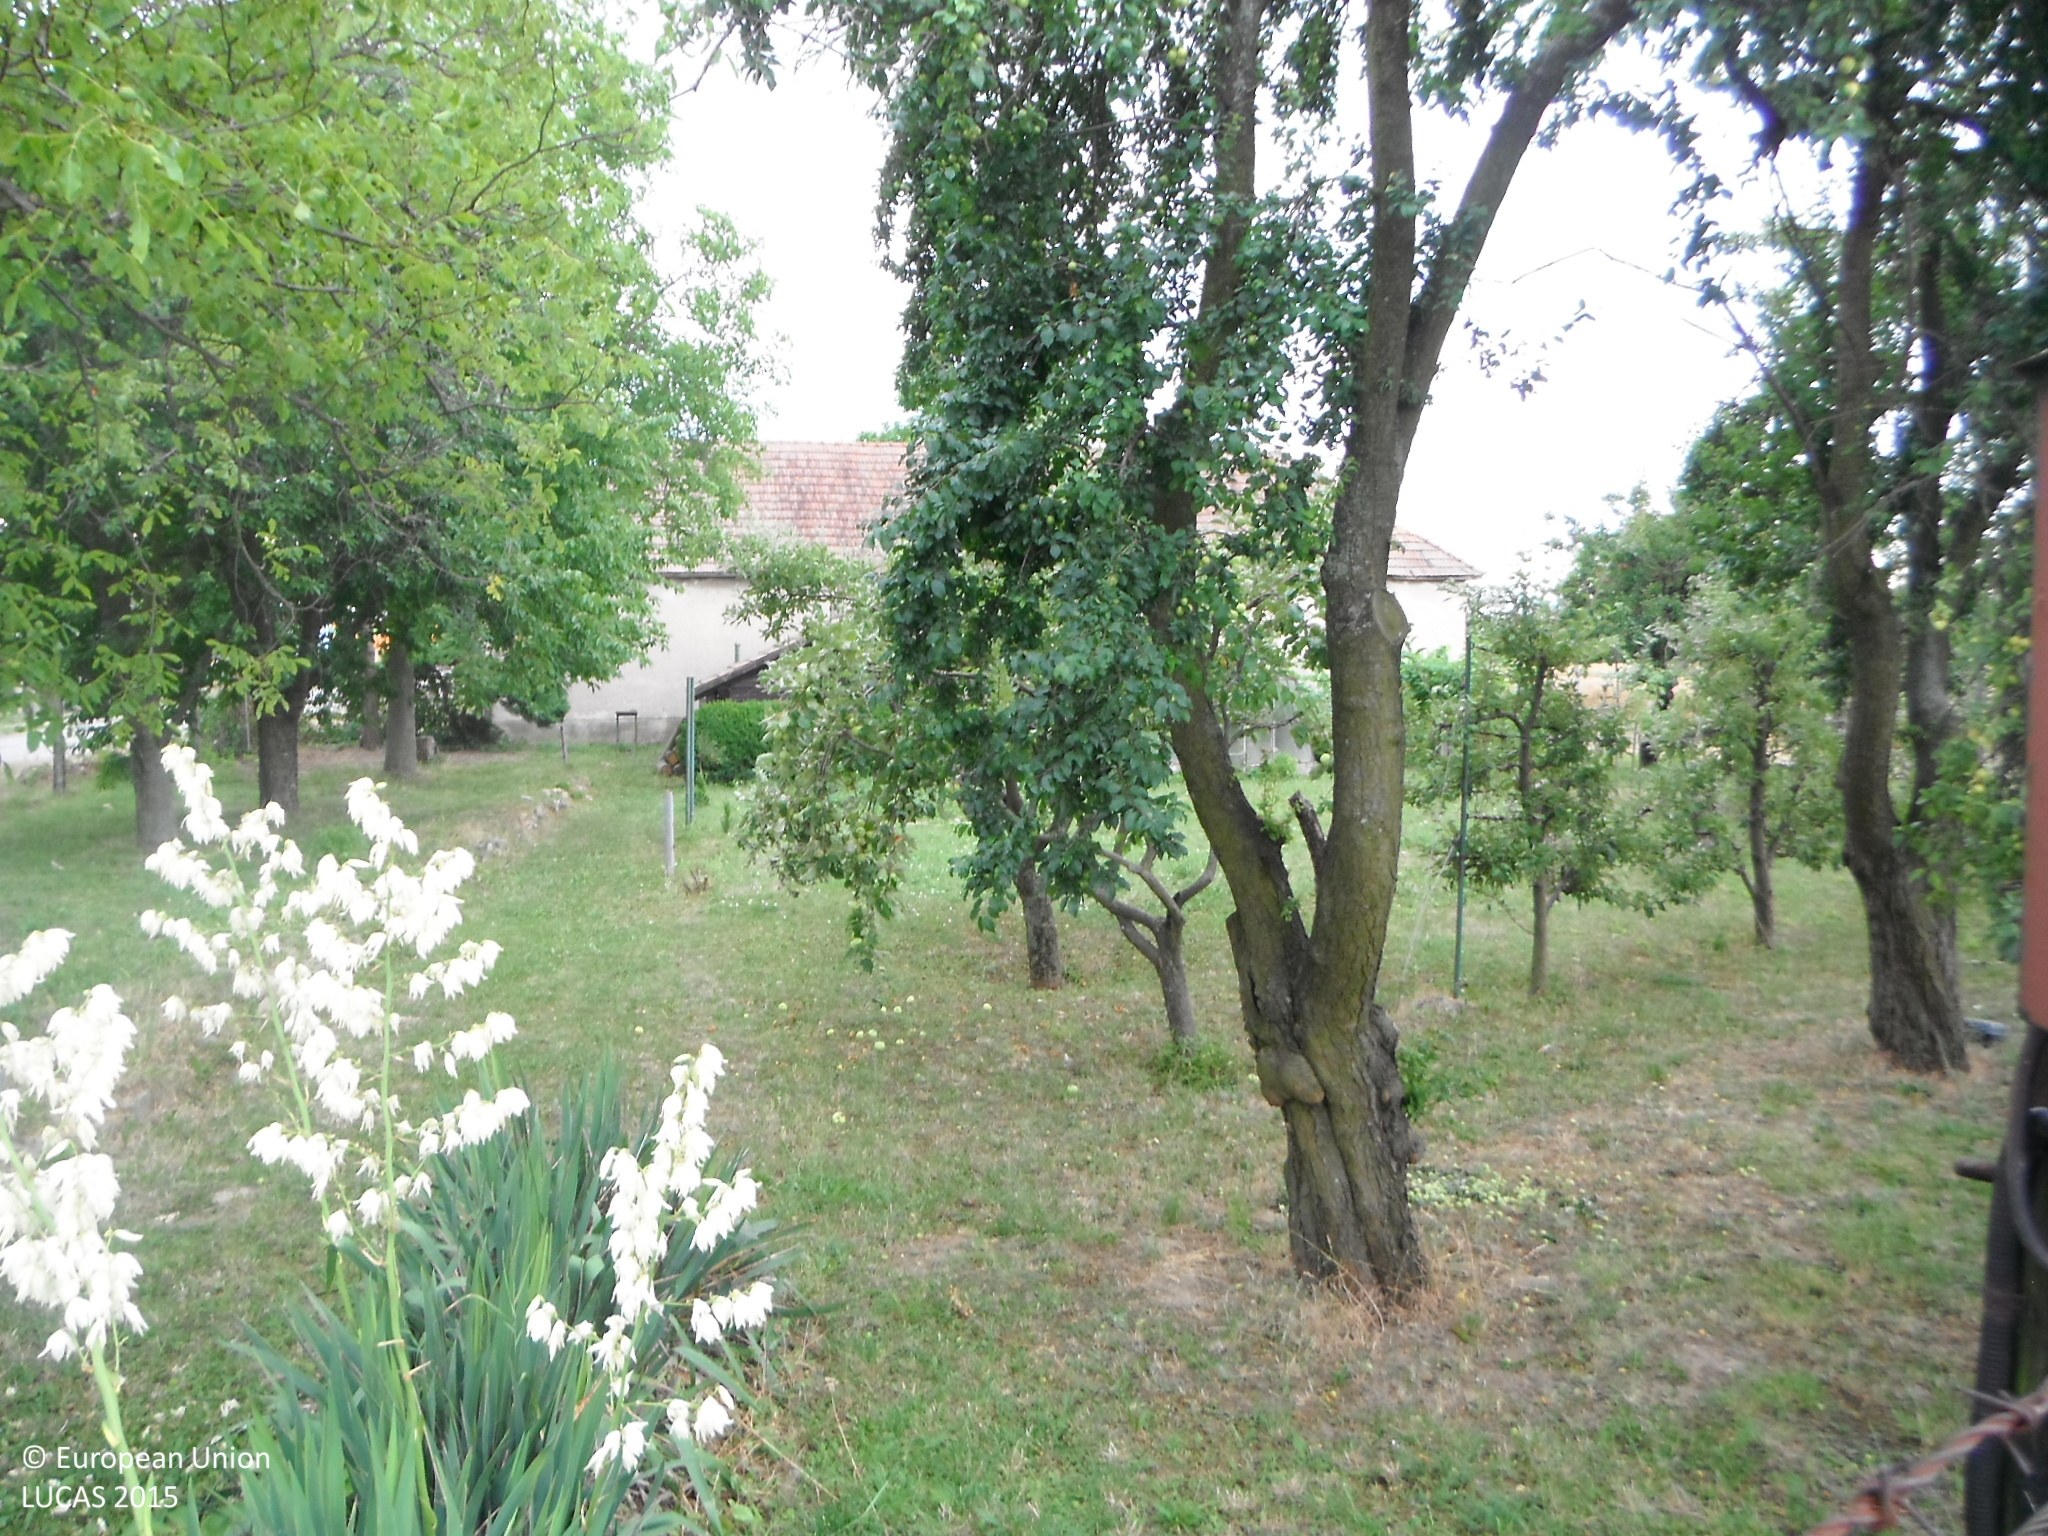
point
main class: Cropland
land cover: Nuts trees
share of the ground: 25 - 50 %
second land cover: Grassland without tree/shrub cover
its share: > 75 %
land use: Kitchen garden
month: July
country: SK
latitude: 48.5836
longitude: 18.2438
